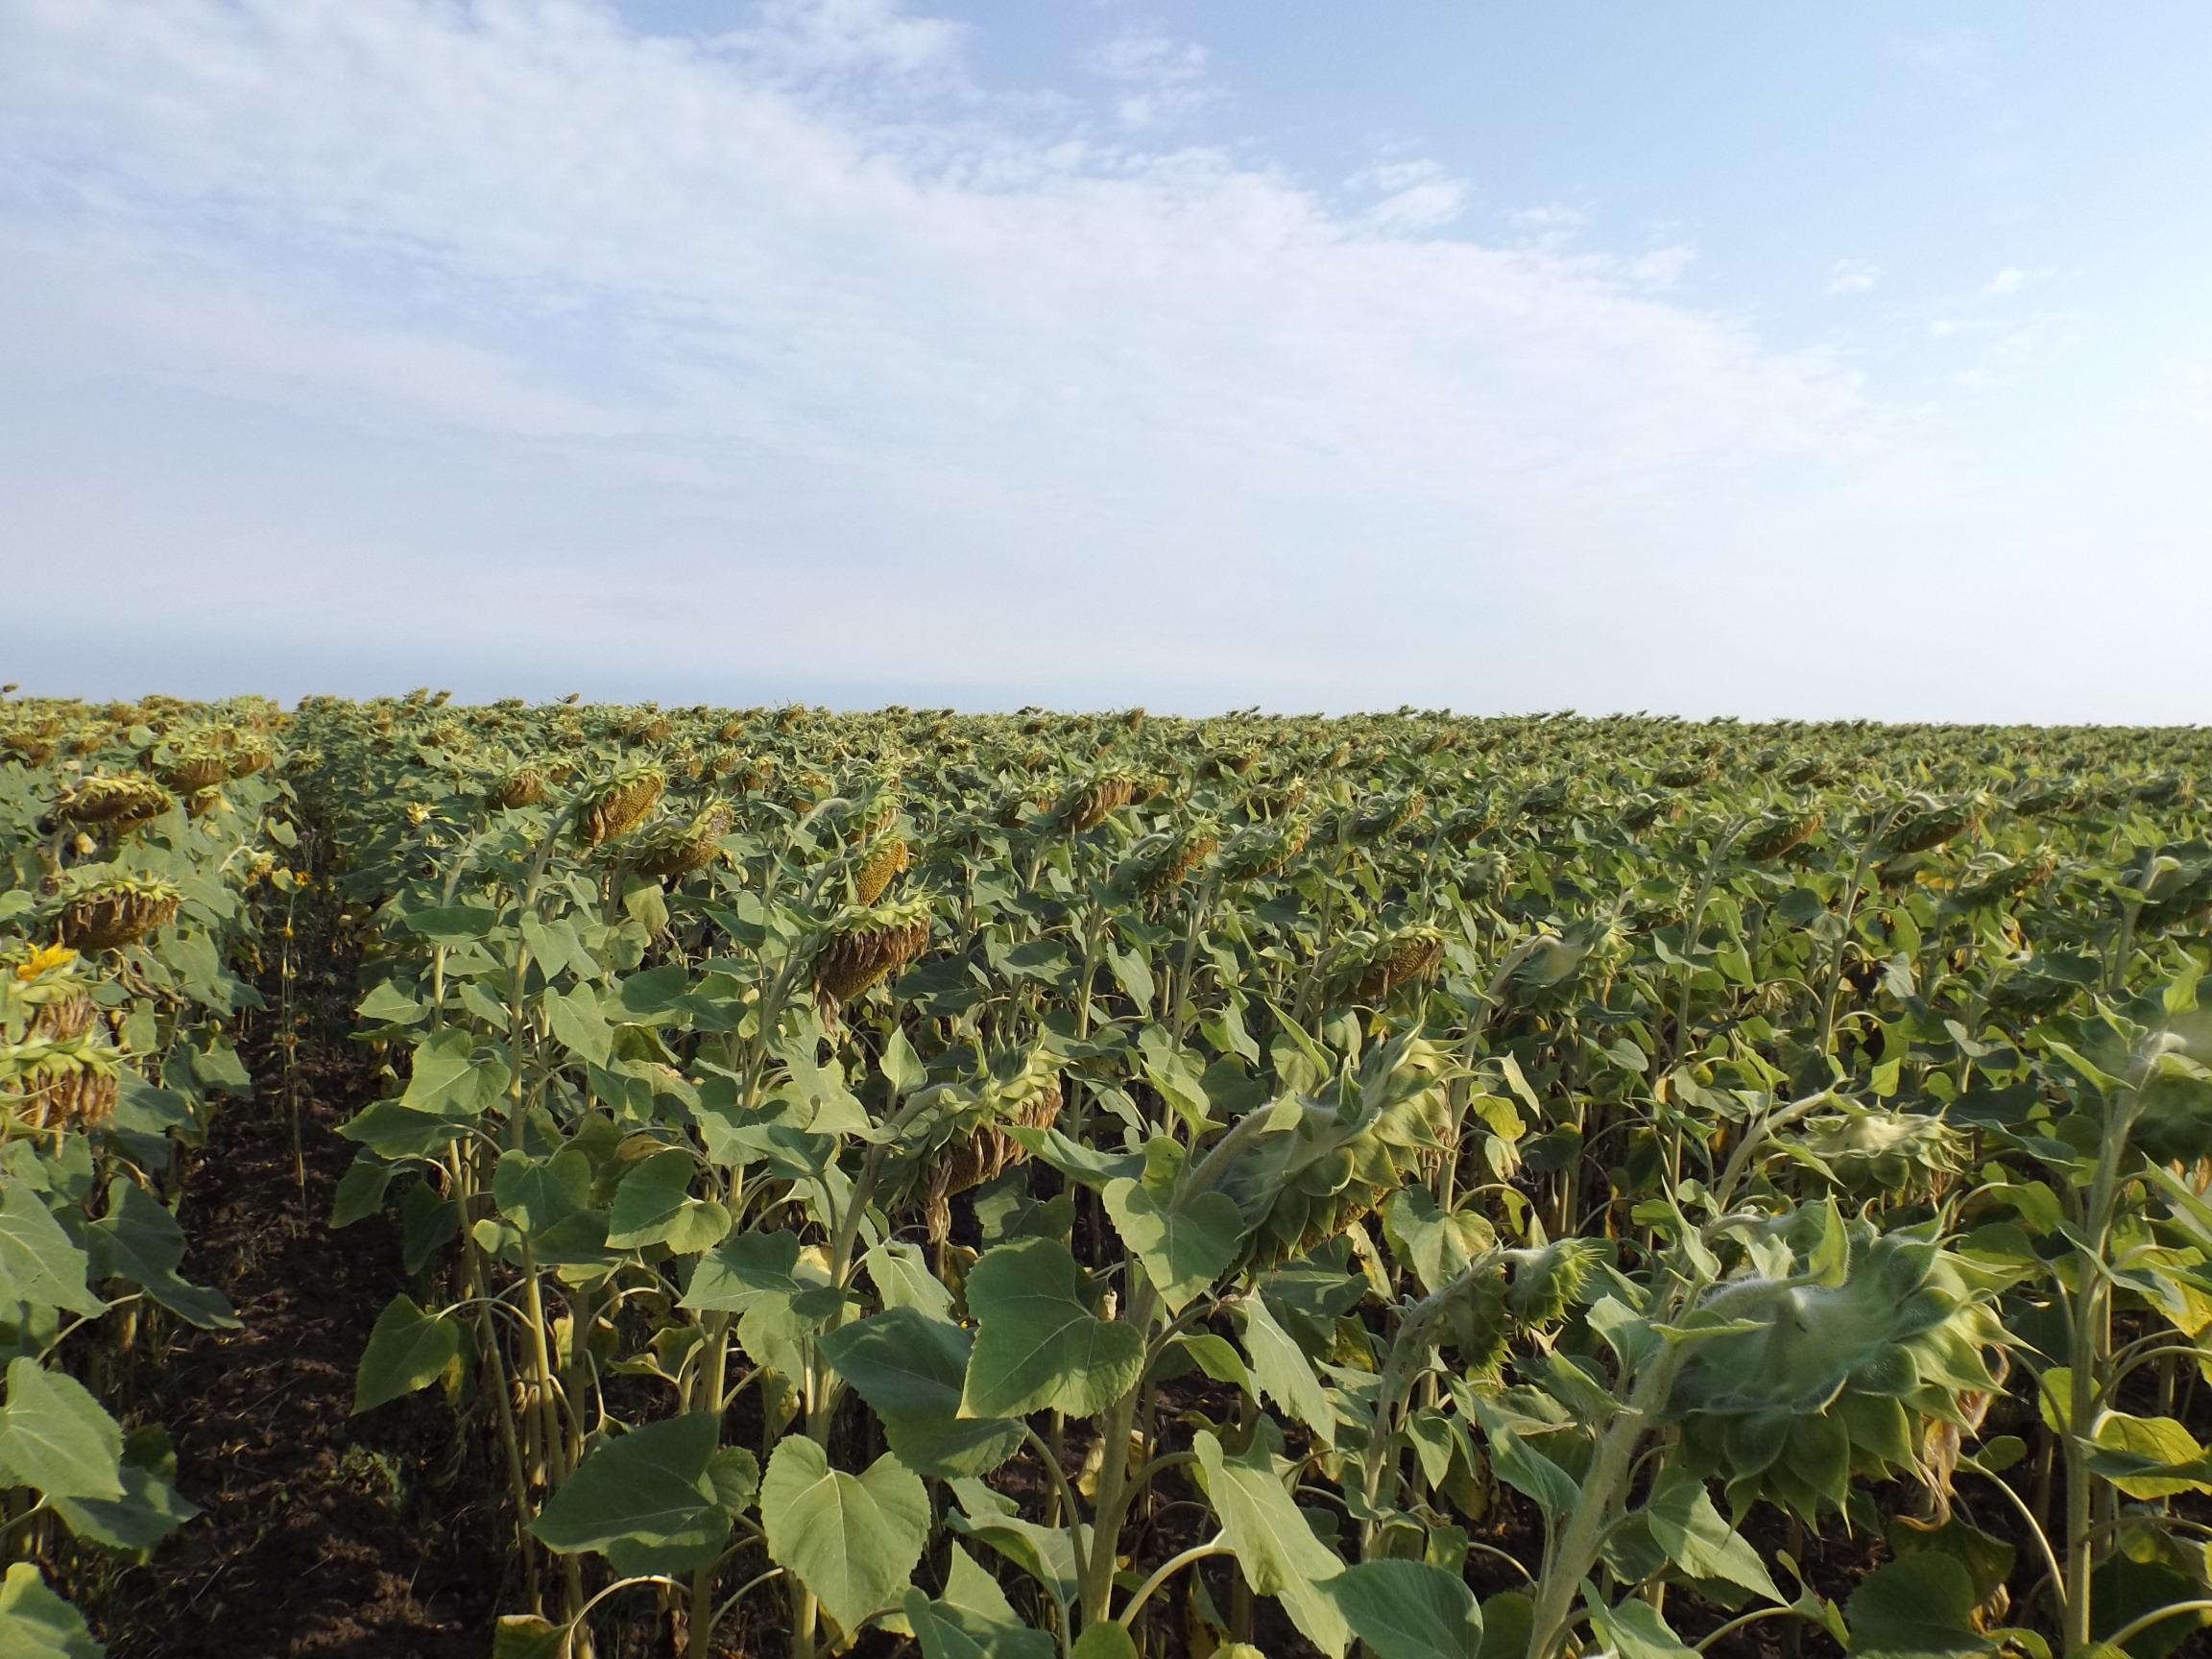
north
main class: Cropland
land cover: Sunflower
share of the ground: 50 - 75 %
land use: Agriculture (excluding fallow land and kitchen gardens)
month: July
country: BG
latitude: 43.5448
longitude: 27.4195
